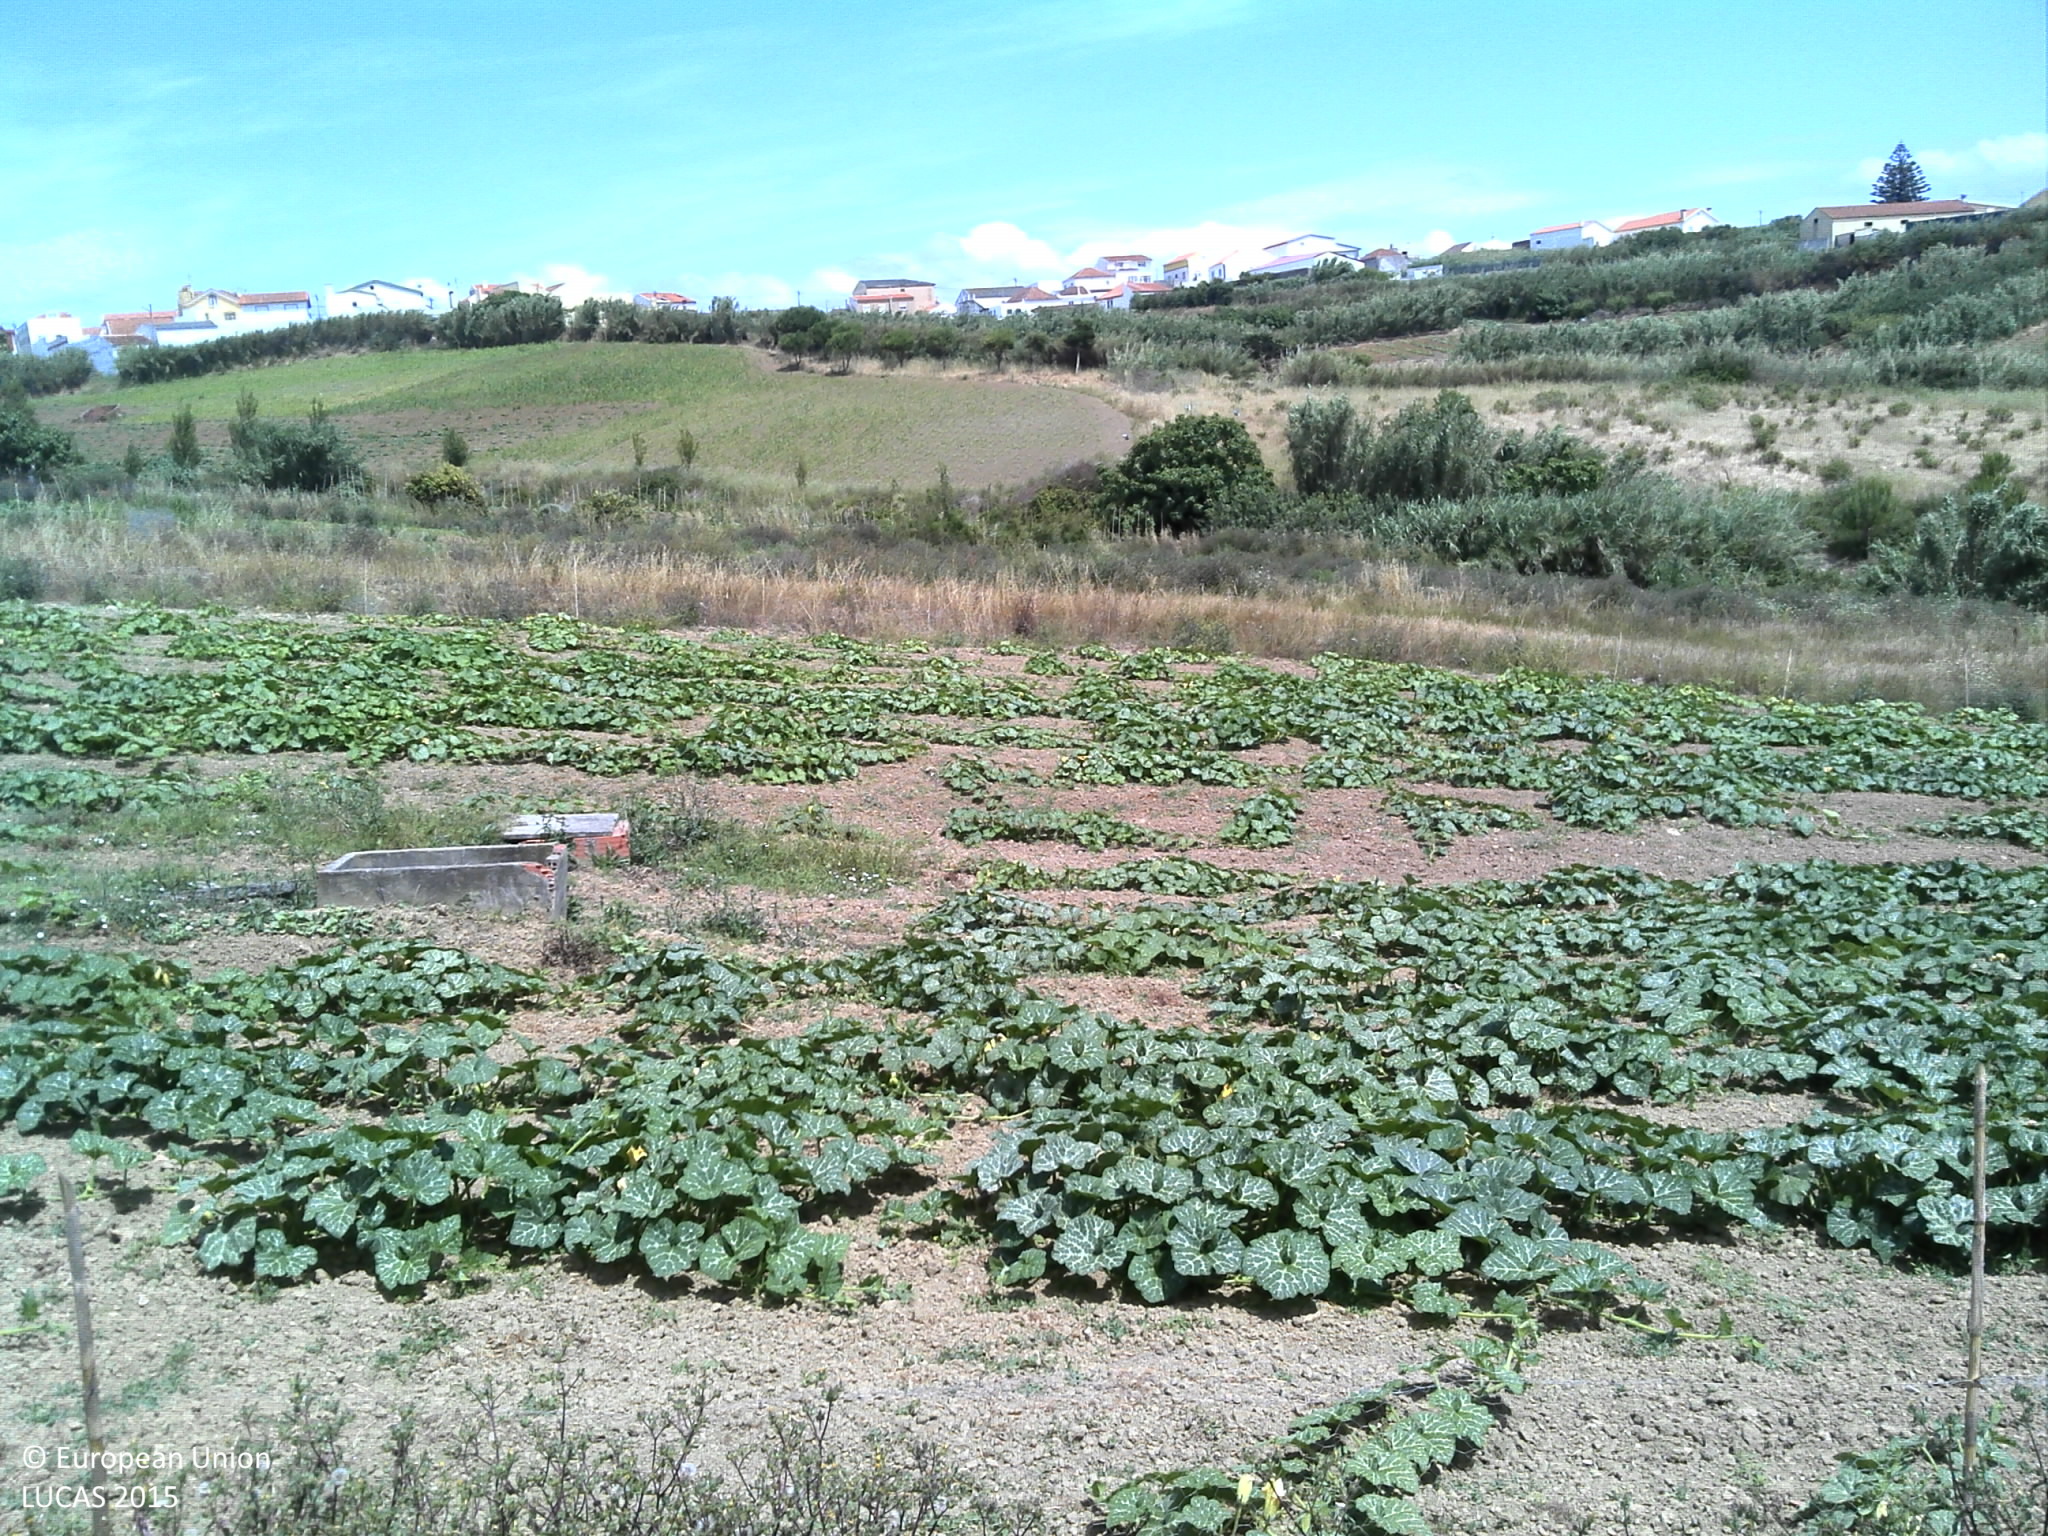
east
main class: Shrubland
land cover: Shrubland without tree cover
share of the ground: 50 - 75 %
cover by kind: shrubs 65 %, herbaceous plants 20 %, unconsolidated bare surface 15 %
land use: Abandoned areas
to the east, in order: Shrubland without tree cover; Other fresh vegetables; Shruby margins; Tracks; Ditches and canals; Grassland without tree/shrub cover; Ditches and canals; Dry pulses; Other fresh vegetables; Rivers and streams; Grass margins; Maize; Shruby margins; Other fresh vegetables
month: June
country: PT
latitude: 39.2320
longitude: -9.3334
